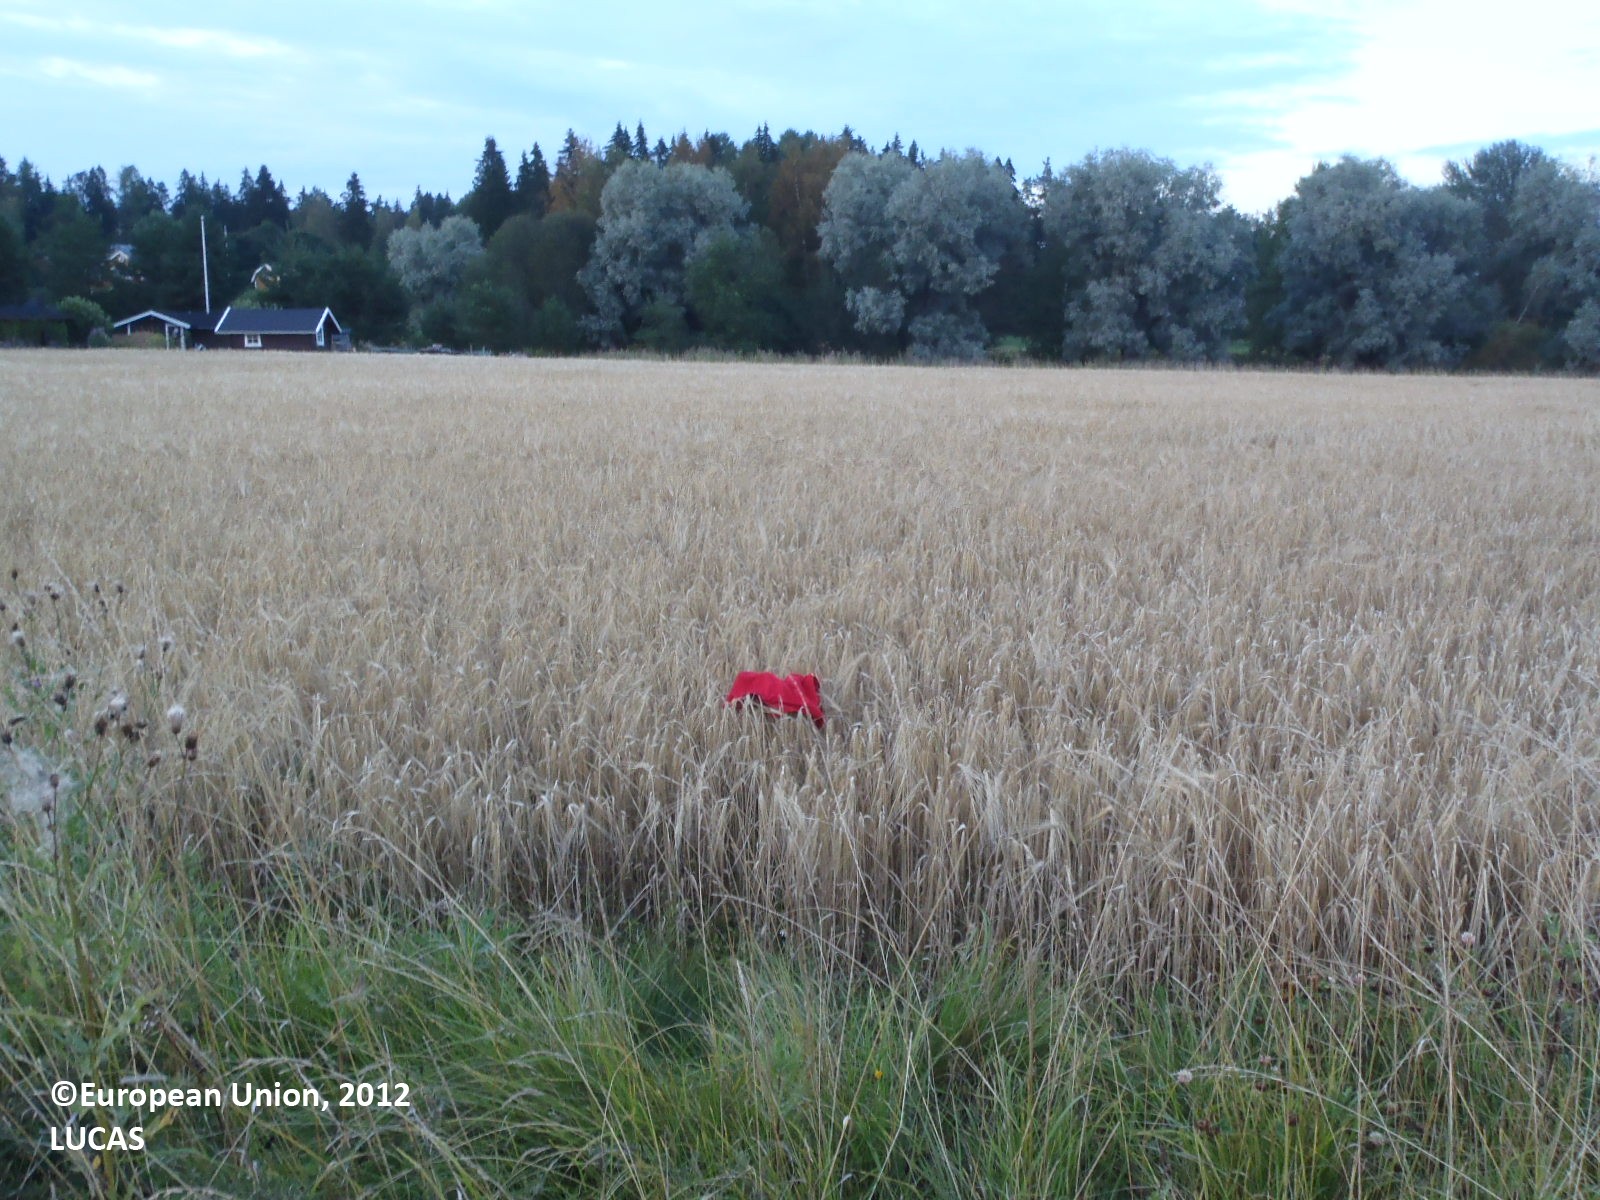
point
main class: Cropland
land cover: Barley
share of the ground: > 75 %
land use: Agriculture (excluding fallow land and kitchen gardens)
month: August
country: FI
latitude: 60.7039
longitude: 22.0256
